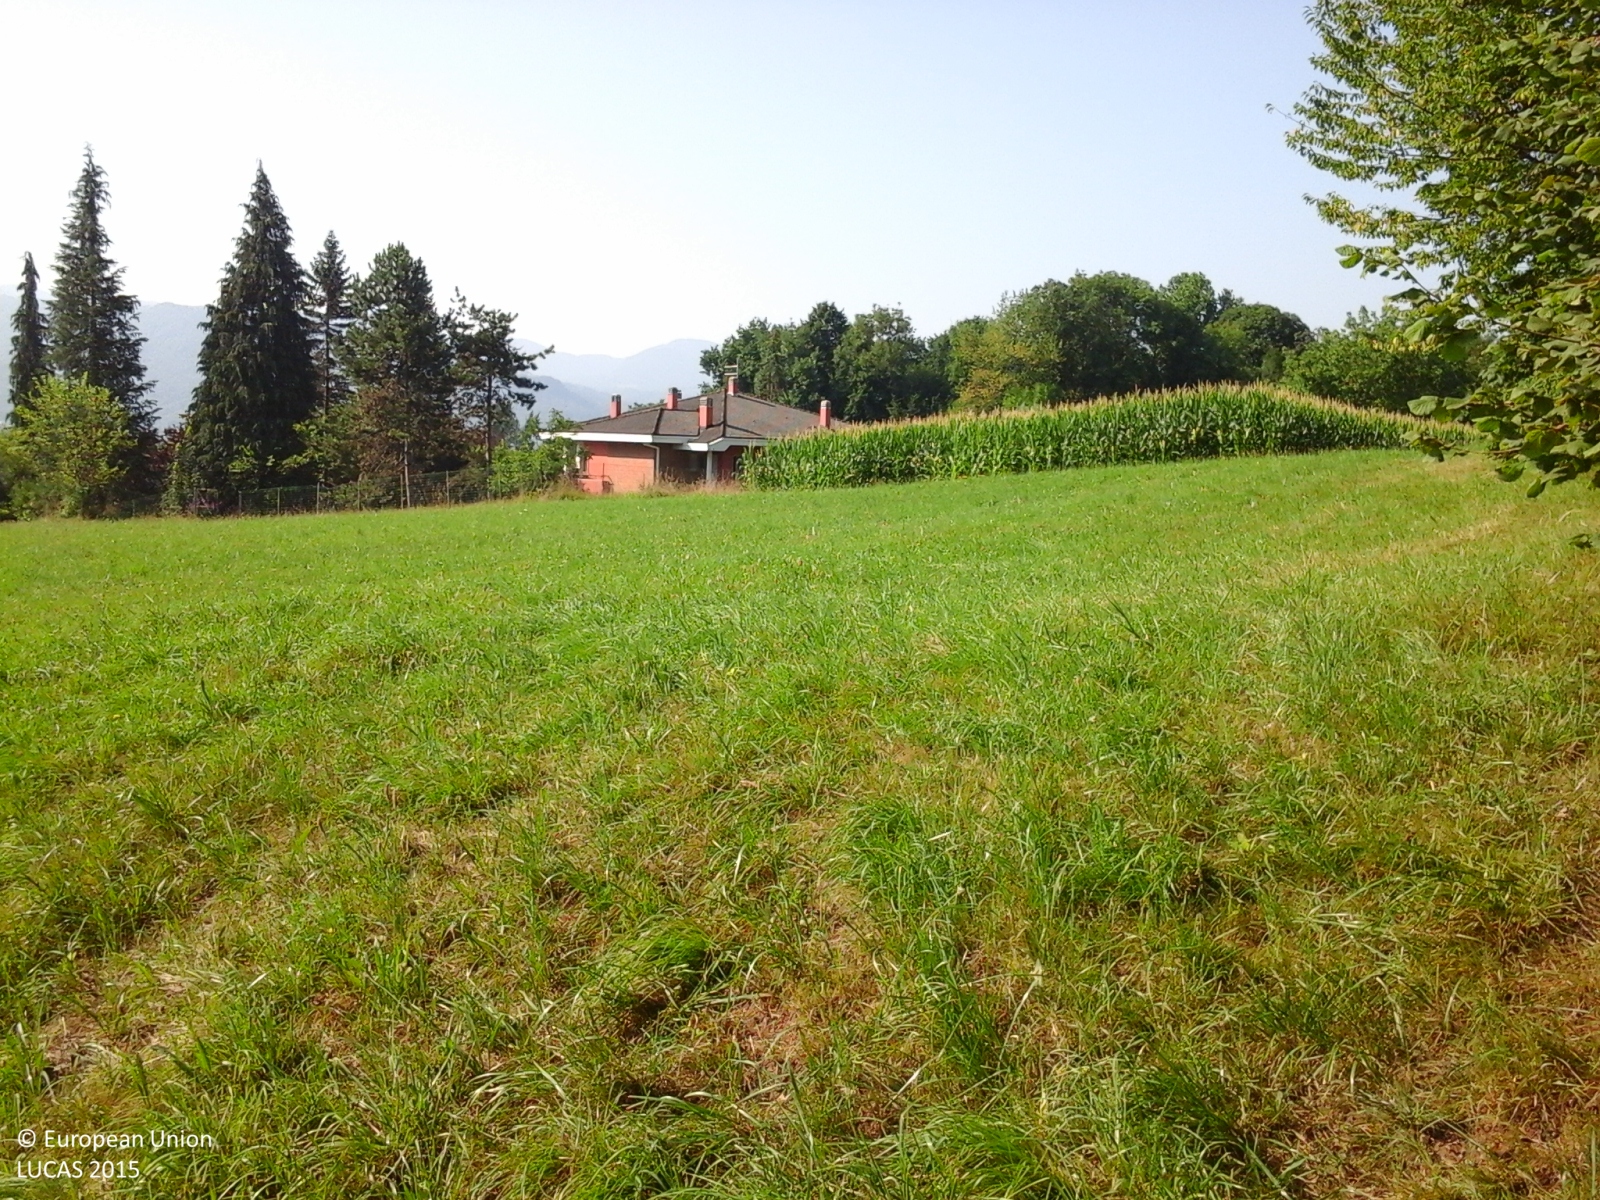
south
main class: Grassland
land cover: Grassland without tree/shrub cover
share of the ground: > 75 %
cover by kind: herbaceous plants 100 %
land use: Agriculture (excluding fallow land and kitchen gardens)
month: July
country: IT
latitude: 46.1307
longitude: 12.1846
